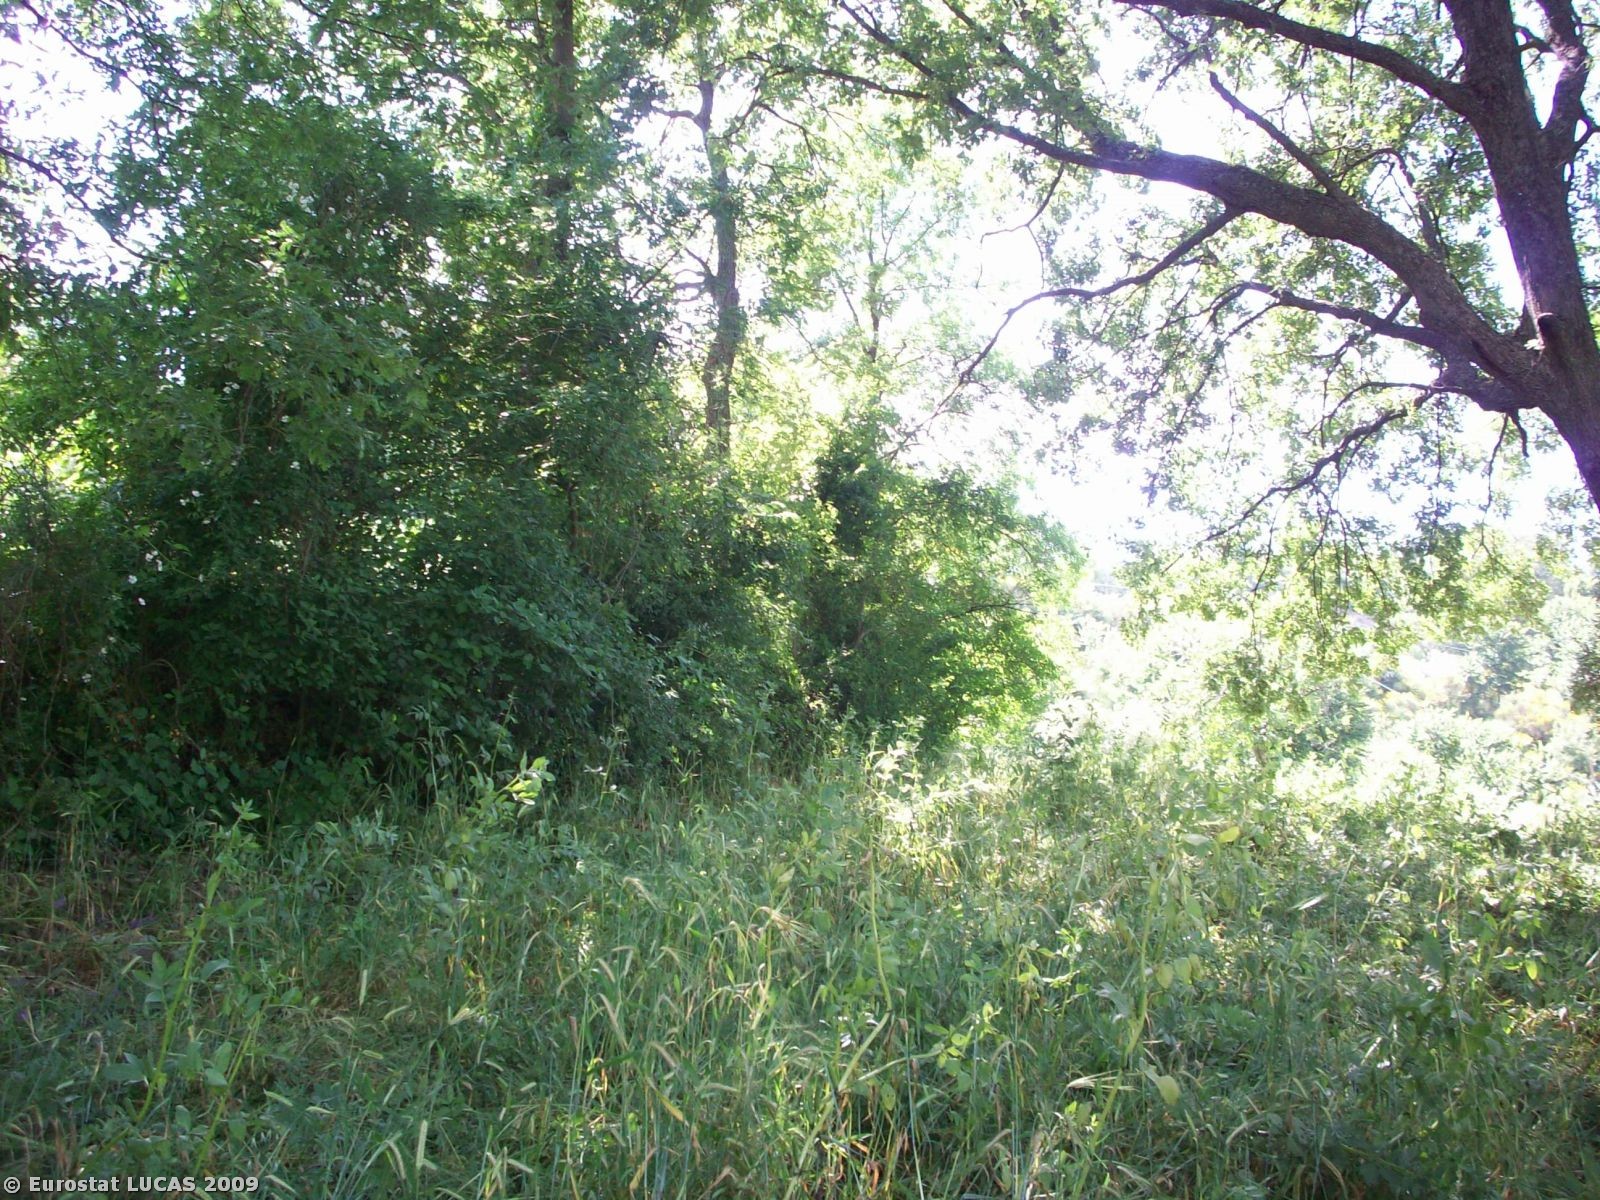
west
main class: Woodland
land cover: Broadleaved woodland
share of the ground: > 75 %
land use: Forestry
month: June
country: IT
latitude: 40.0862
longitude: 16.2485
